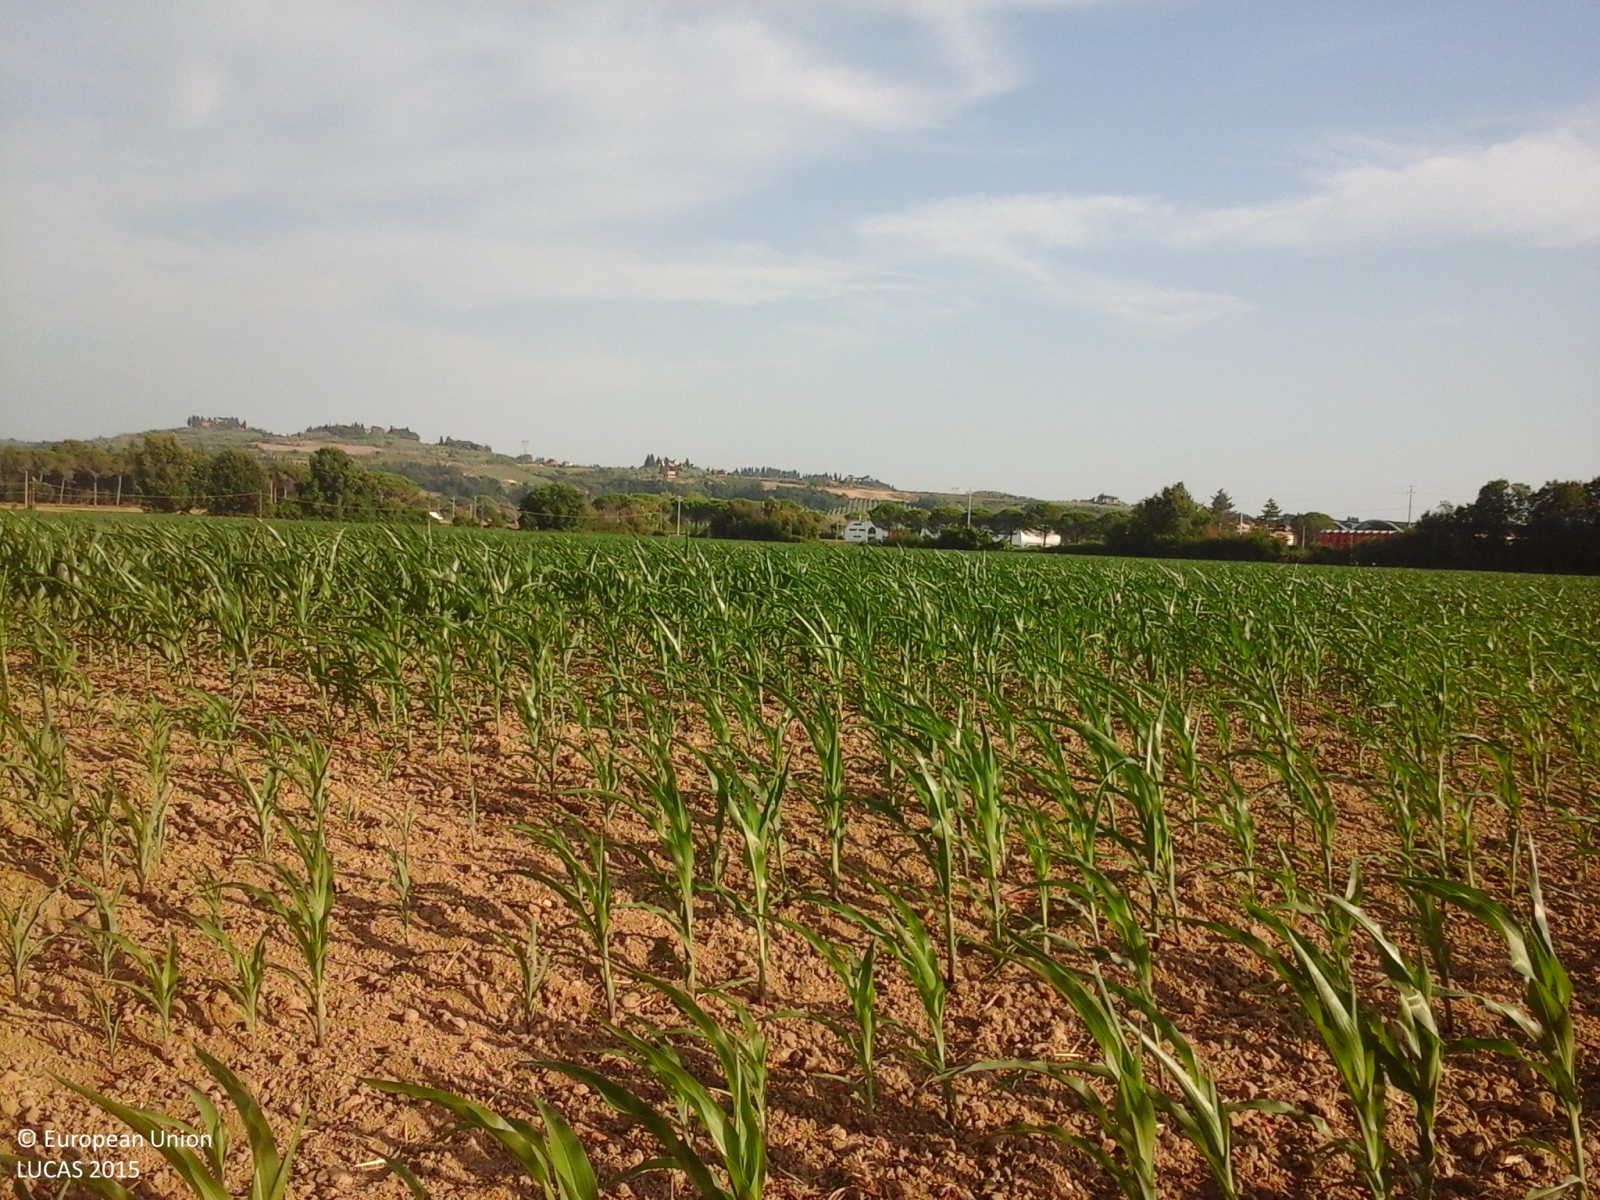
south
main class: Cropland
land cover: Maize
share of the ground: > 75 %
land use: Agriculture (excluding fallow land and kitchen gardens)
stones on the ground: < 10 %
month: July
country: IT
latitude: 43.7145
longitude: 10.9779
